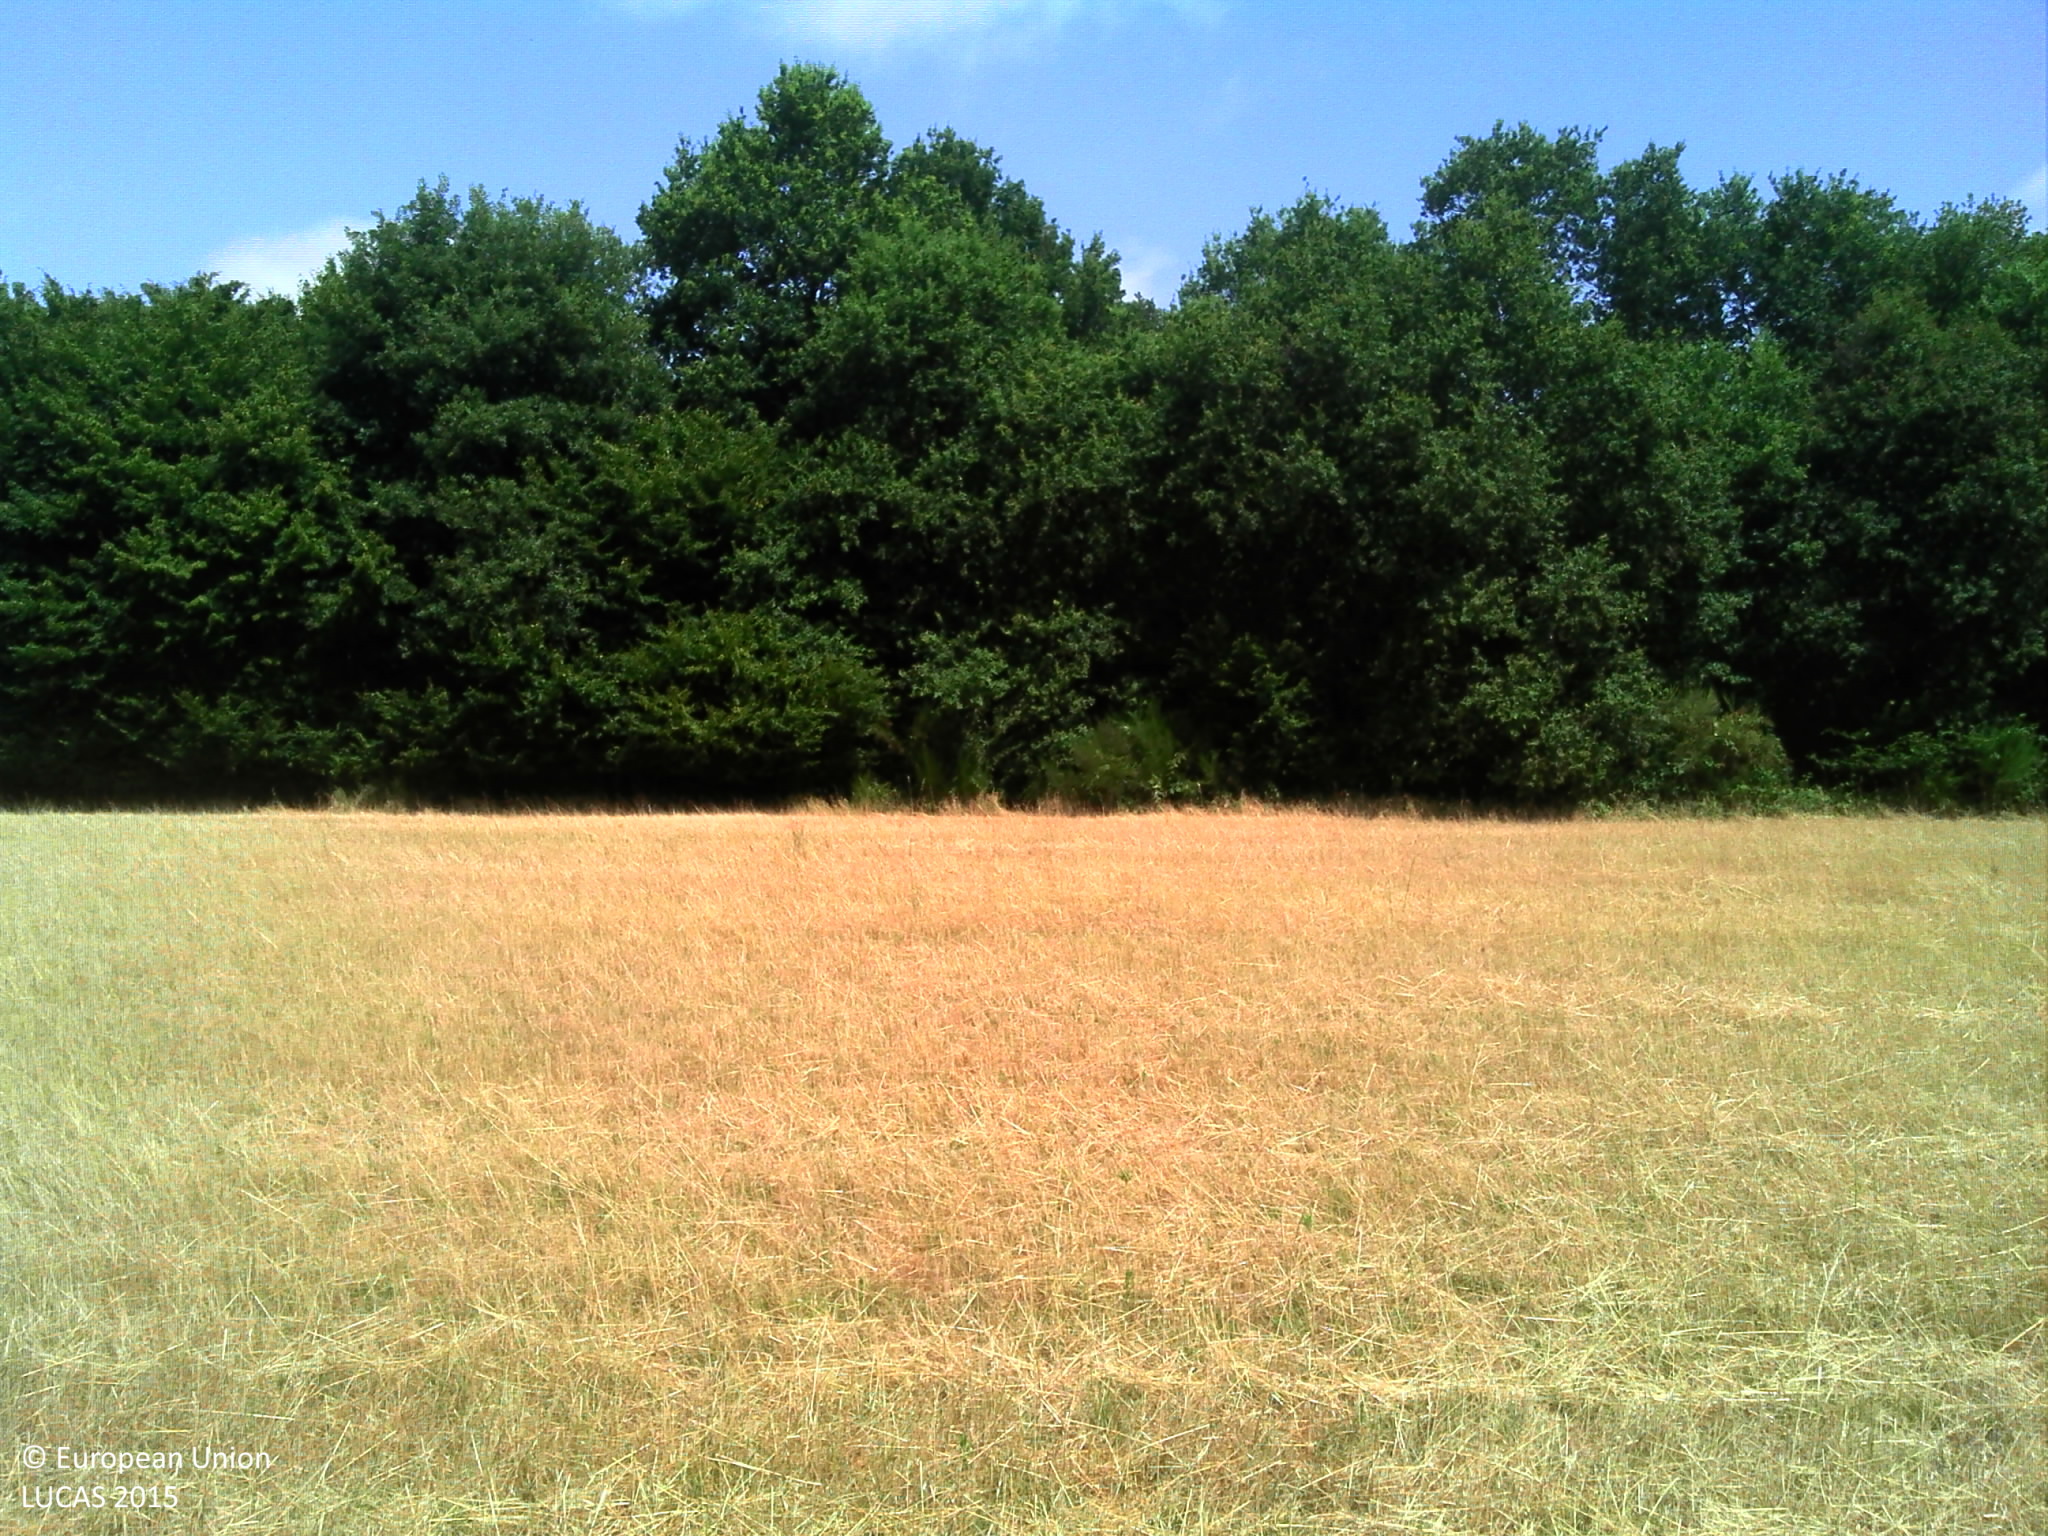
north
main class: Grassland
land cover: Grassland without tree/shrub cover
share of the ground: > 75 %
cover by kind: herbaceous plants 100 %
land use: Agriculture (excluding fallow land and kitchen gardens)
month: July
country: FR
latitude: 47.1822
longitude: 0.5450
